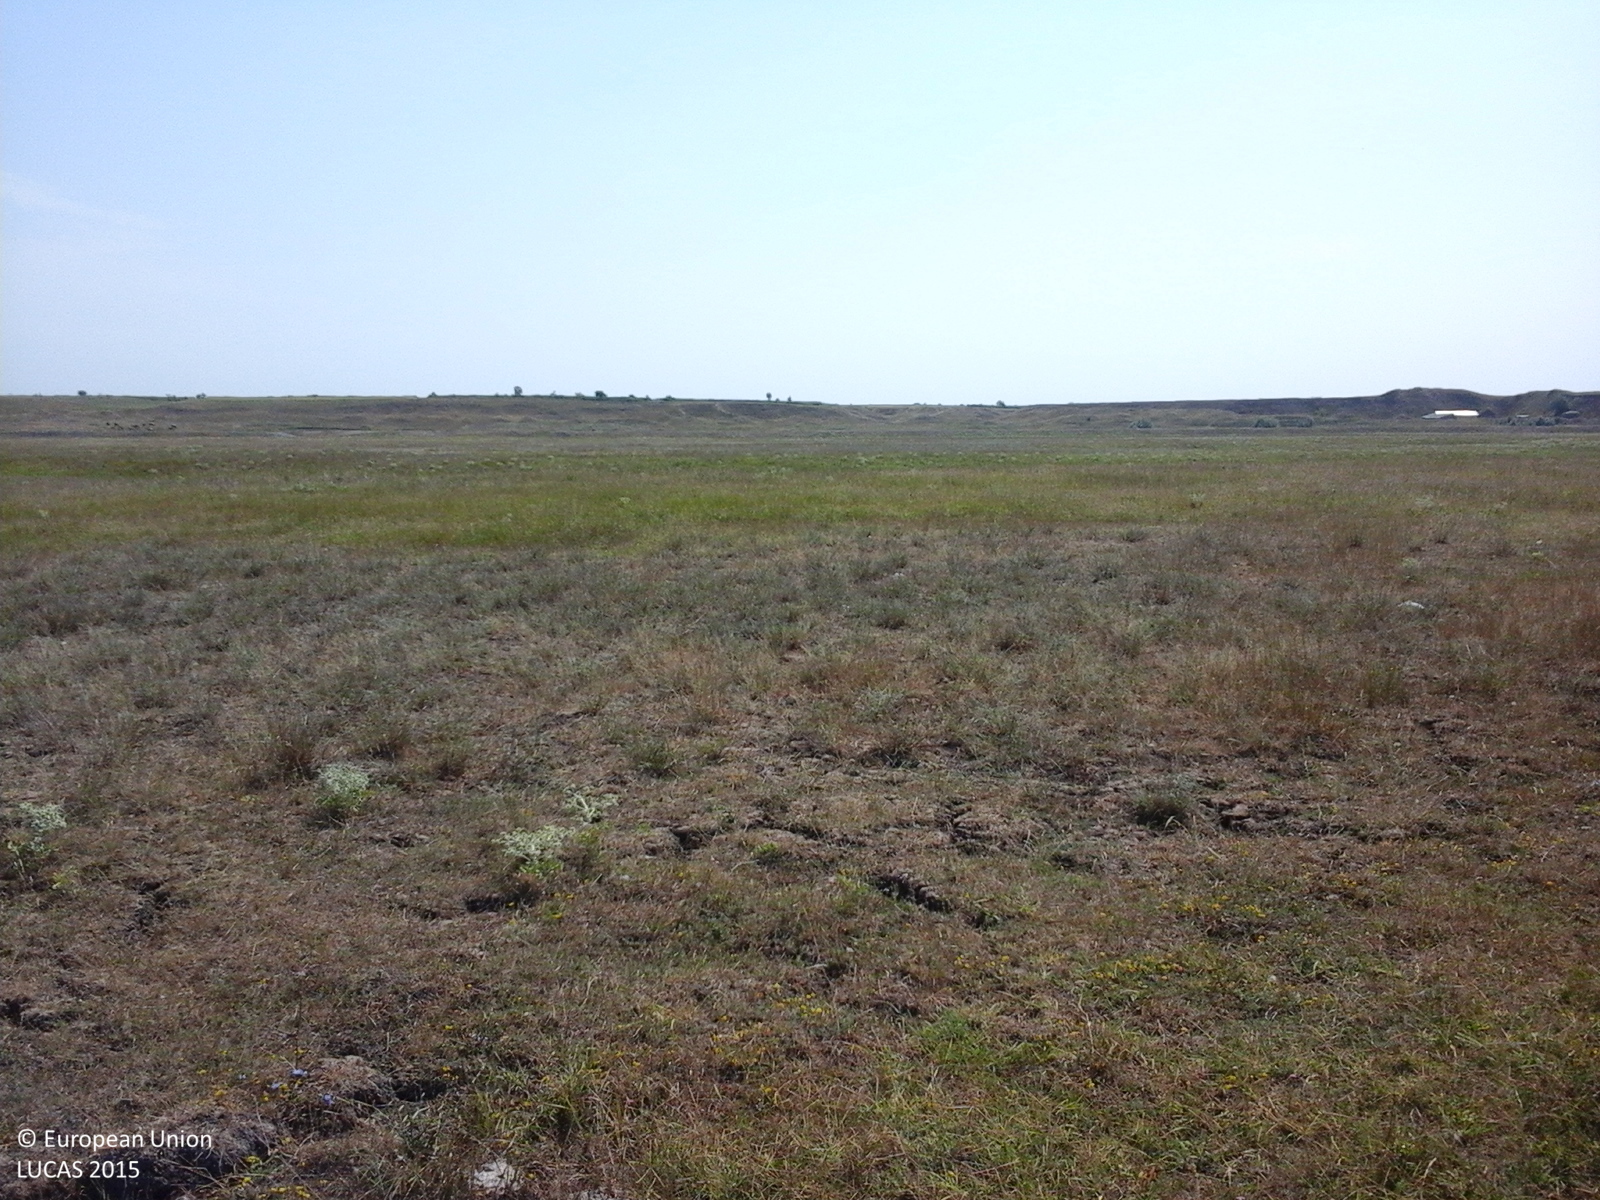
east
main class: Grassland
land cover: Grassland without tree/shrub cover
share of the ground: > 75 %
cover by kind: herbaceous plants 100 %
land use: Agriculture (excluding fallow land and kitchen gardens)
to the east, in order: Grassland without tree/shrub cover
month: July
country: RO
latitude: 45.8593
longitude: 27.4532
